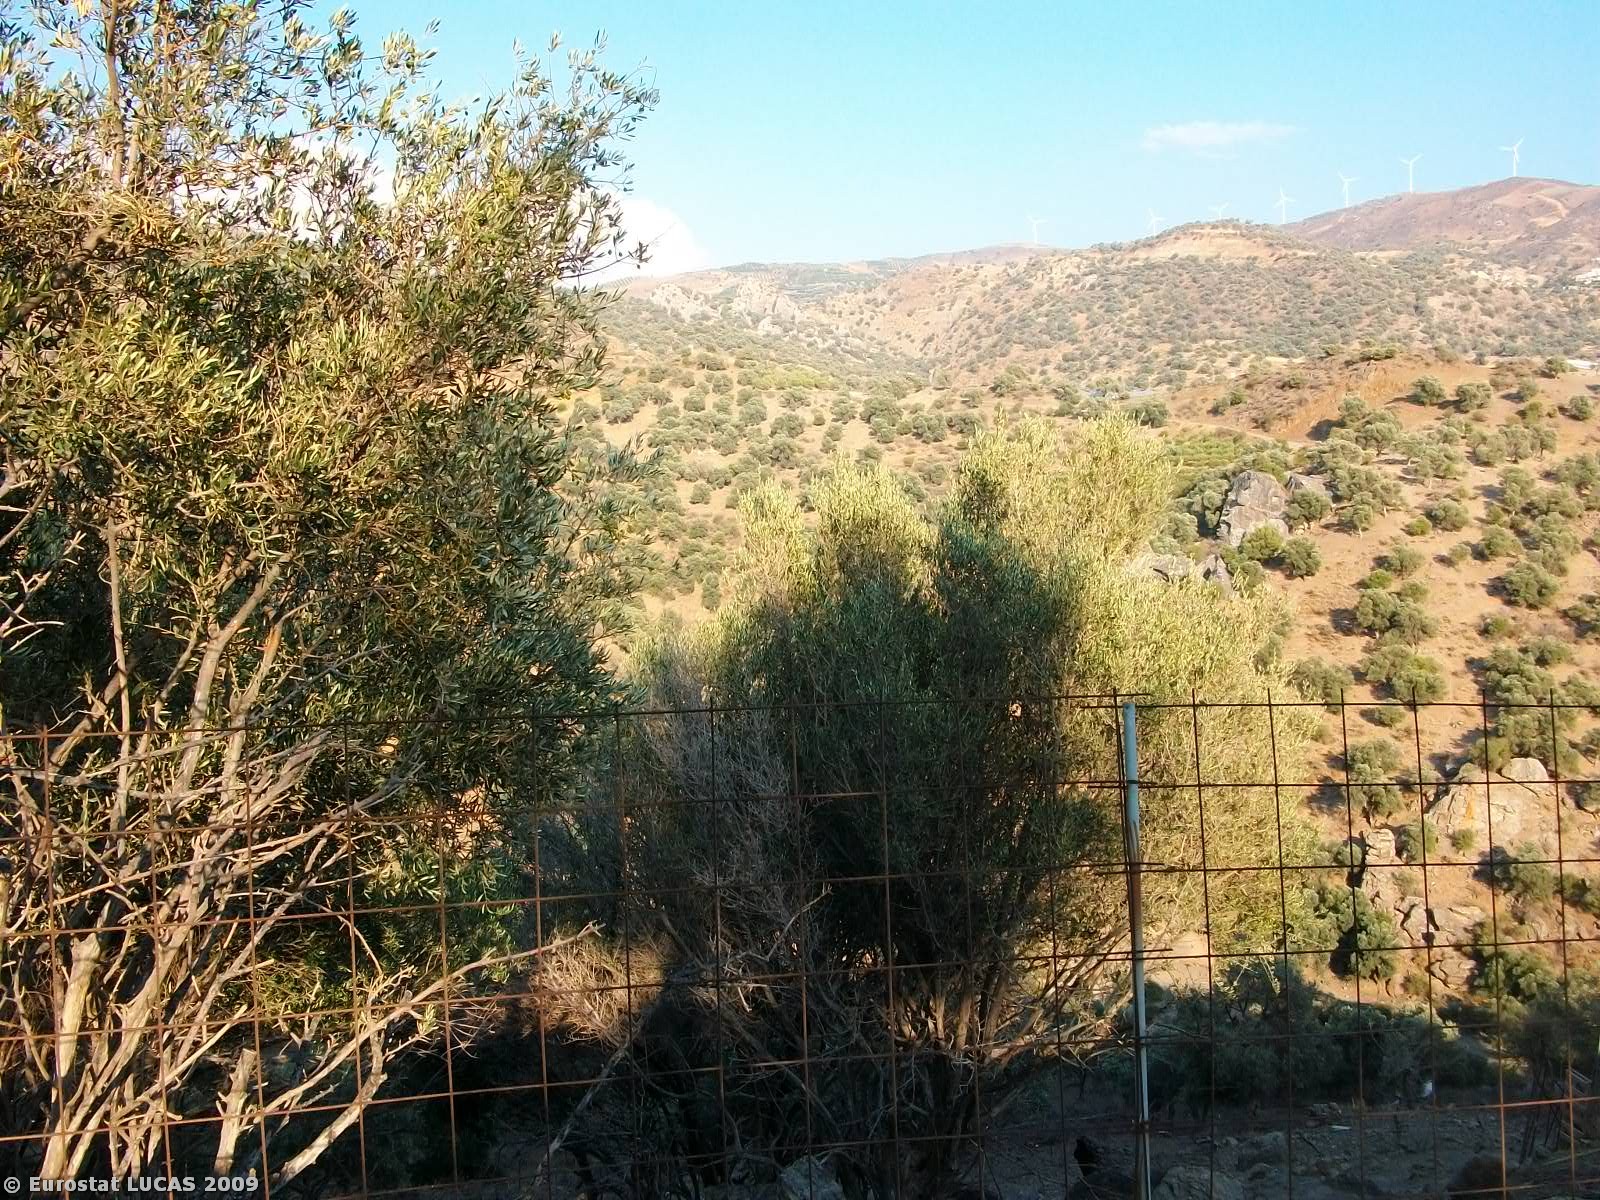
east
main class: Shrubland
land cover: Shrubland with sparse tree cover
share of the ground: 50 - 75 %
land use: Agriculture (excluding fallow land and kitchen gardens)
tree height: < 5 m
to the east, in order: Shrubland with sparse tree cover; Rivers and streams; Shrubland with sparse tree cover
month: June
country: GR
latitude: 34.9689
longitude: 24.8676
